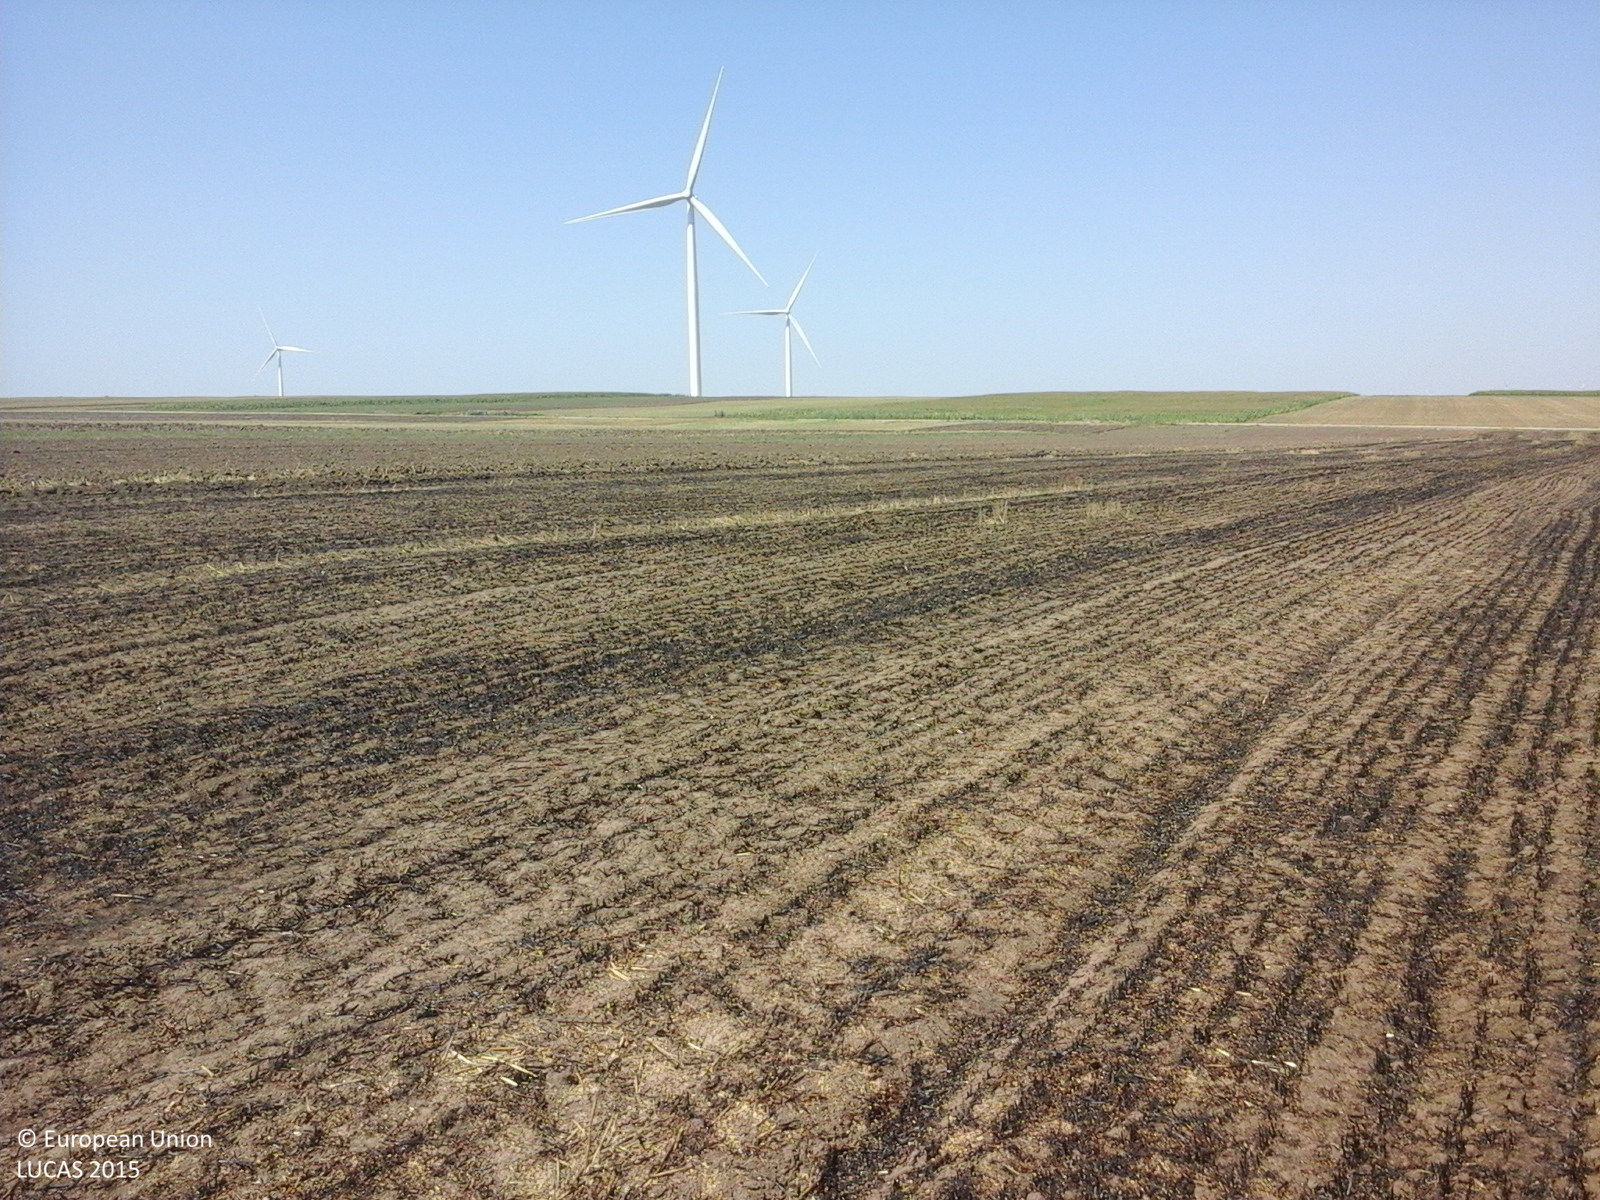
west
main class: Cropland
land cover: Common wheat
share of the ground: < 10 %
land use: Agriculture (excluding fallow land and kitchen gardens)
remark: Burnt area
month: August
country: RO
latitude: 44.3718
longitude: 28.3775
